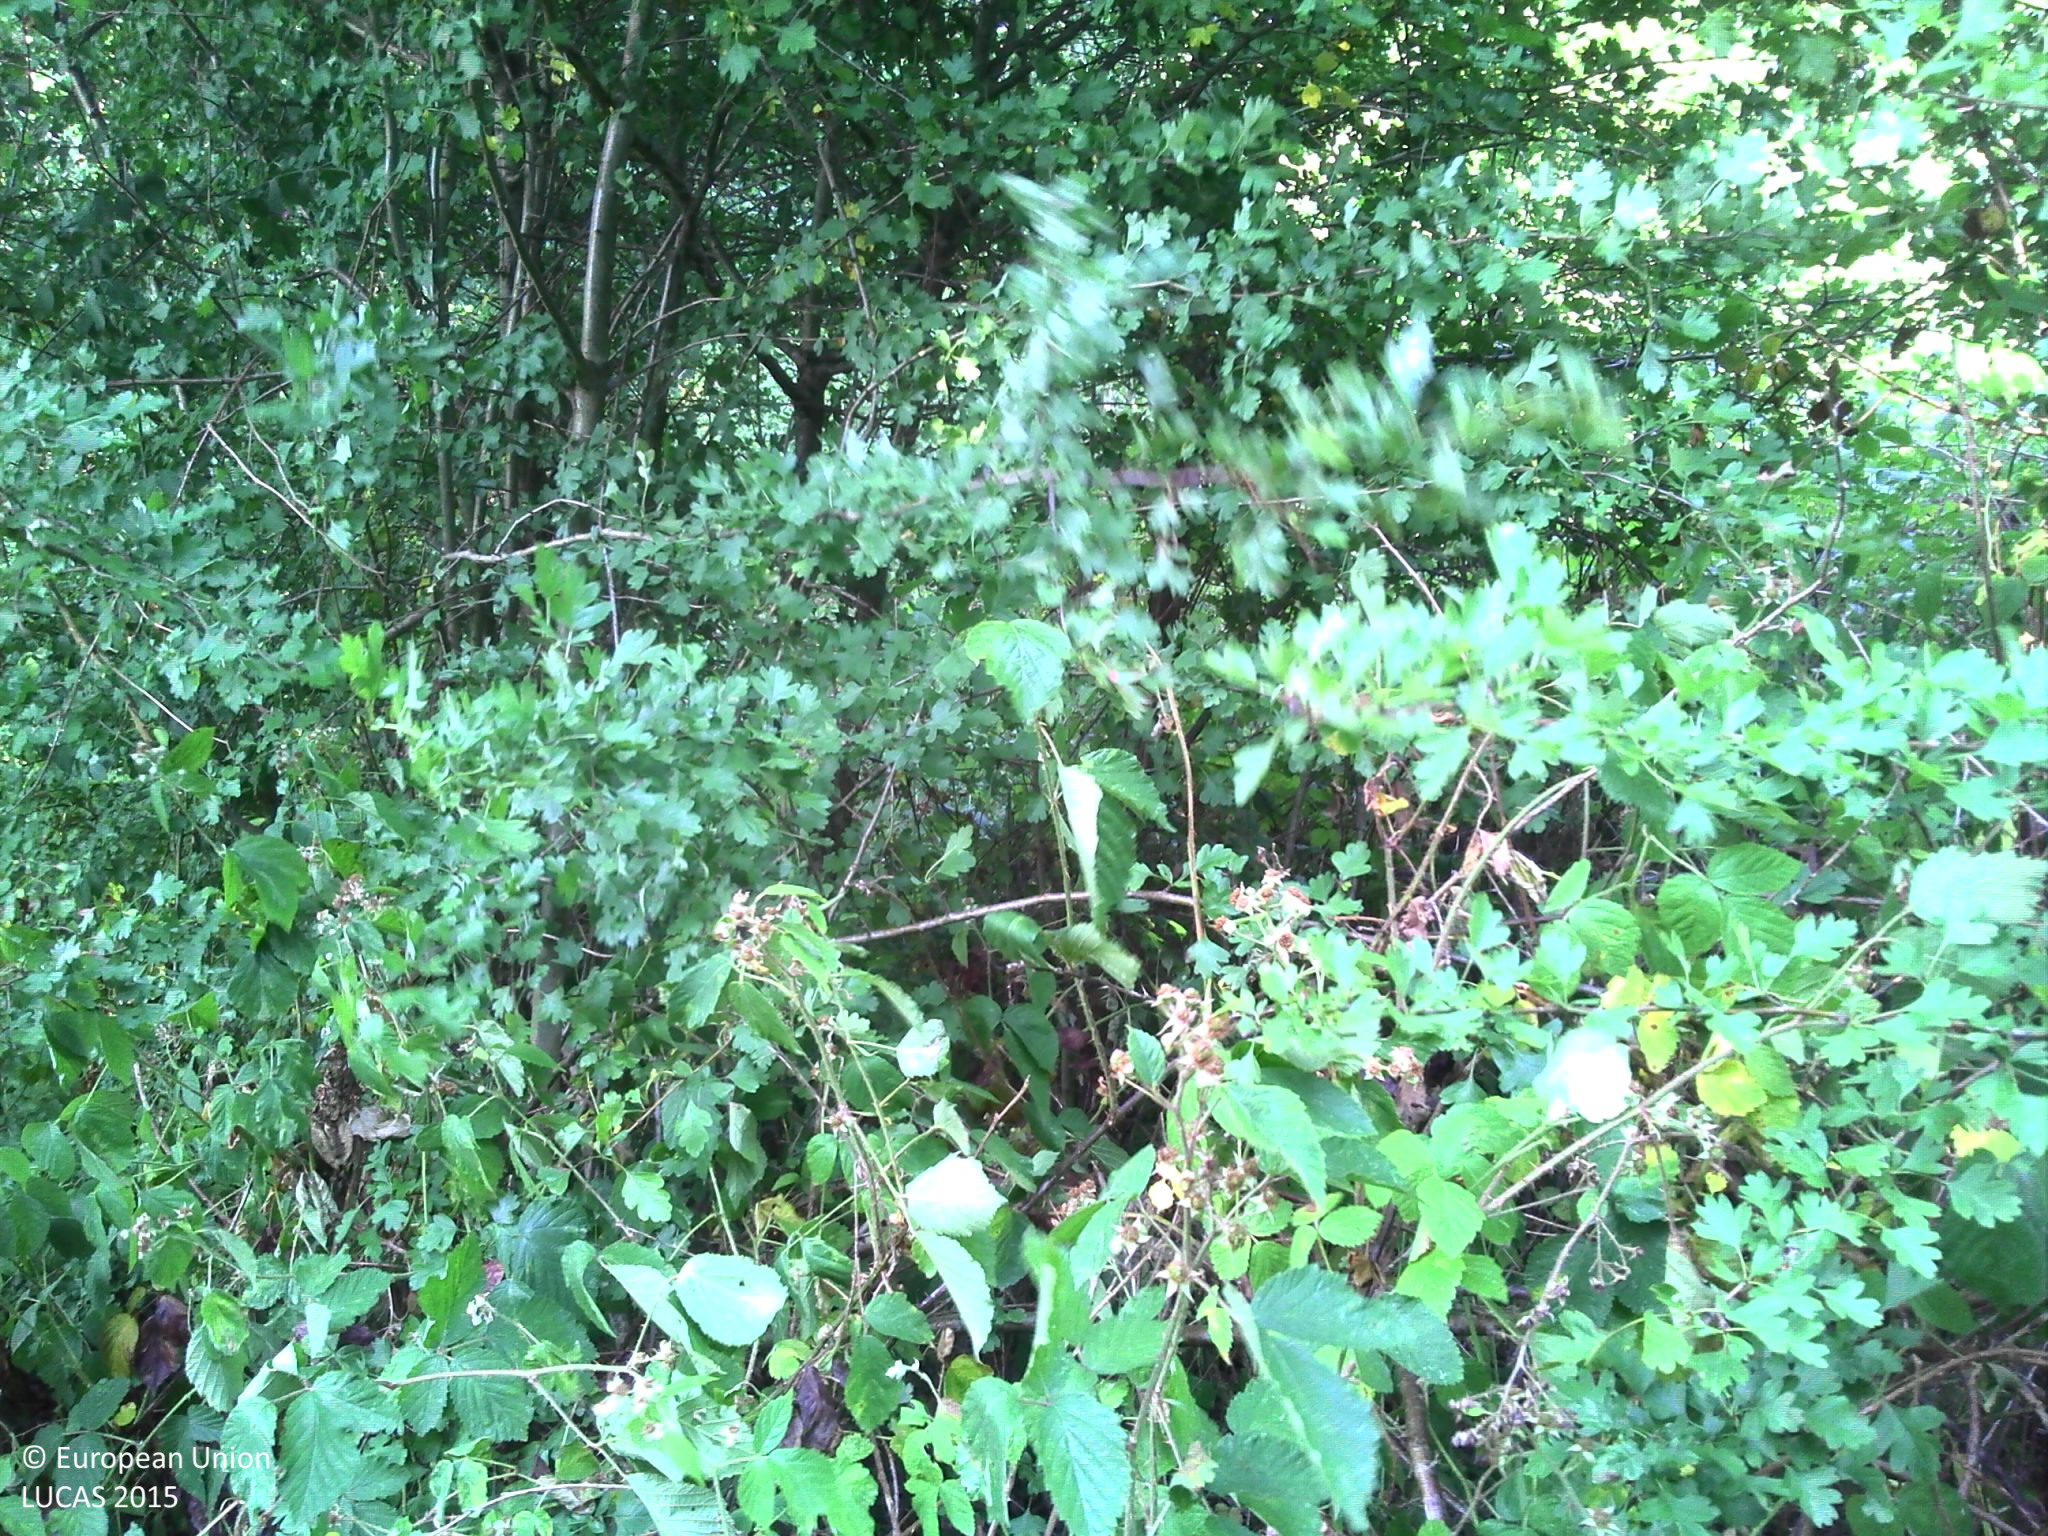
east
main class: Woodland
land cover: Broadleaved woodland
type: mesophytic deciduous forest
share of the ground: > 75 %
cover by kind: broadleaved forest trees 70 %, herbaceous plants 30 %
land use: Forestry
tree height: > 5 m
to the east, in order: Broadleaved woodland; Tracks; Common wheat; Fences; Grassland with sparse tree/shrub cover
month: July
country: FR
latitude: 48.8918
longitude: 1.2927
